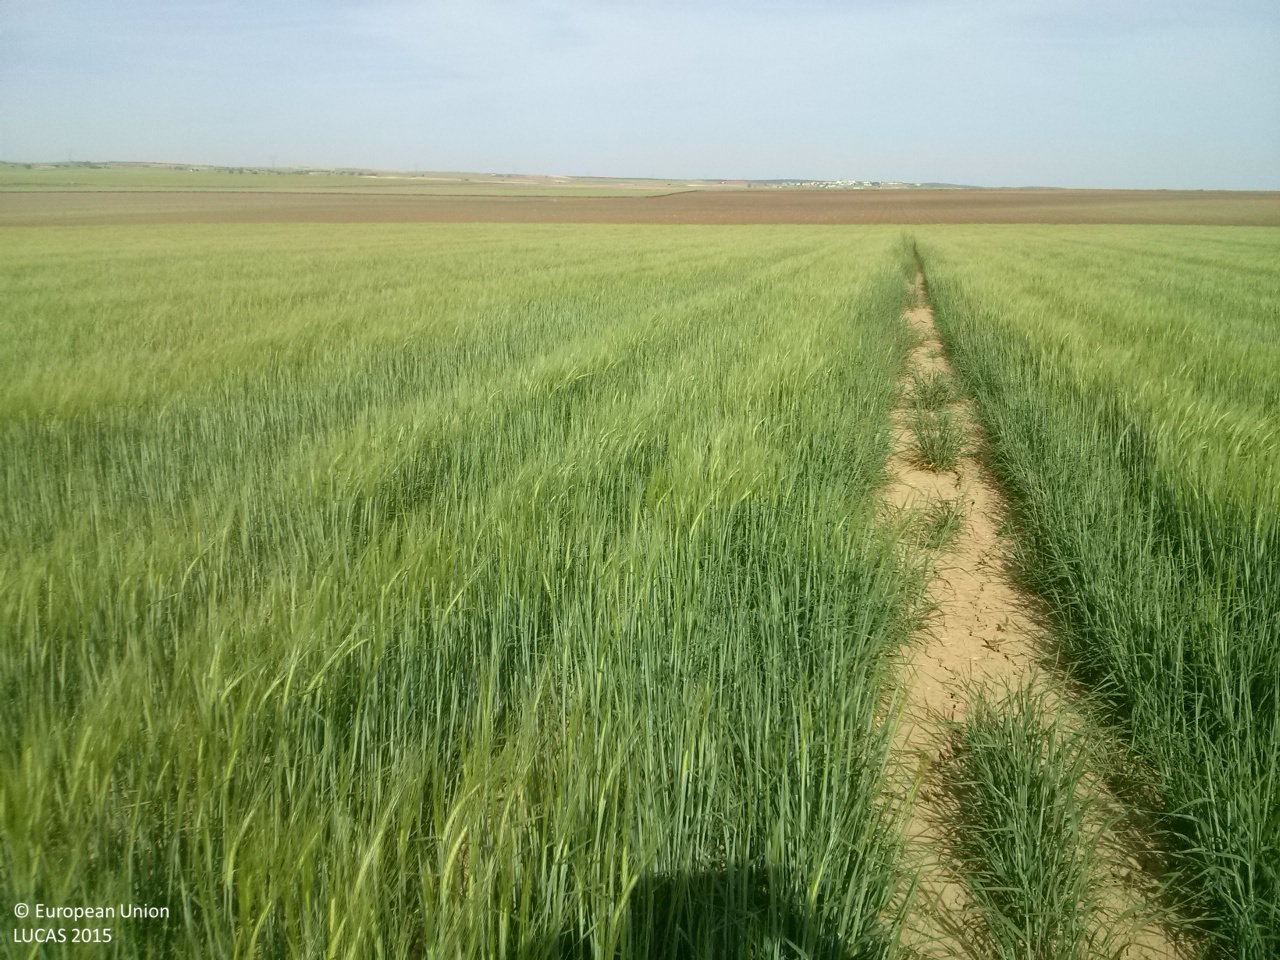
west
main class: Cropland
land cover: Barley
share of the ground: > 75 %
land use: Agriculture (excluding fallow land and kitchen gardens)
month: May
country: ES
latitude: 39.8471
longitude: -2.6519
